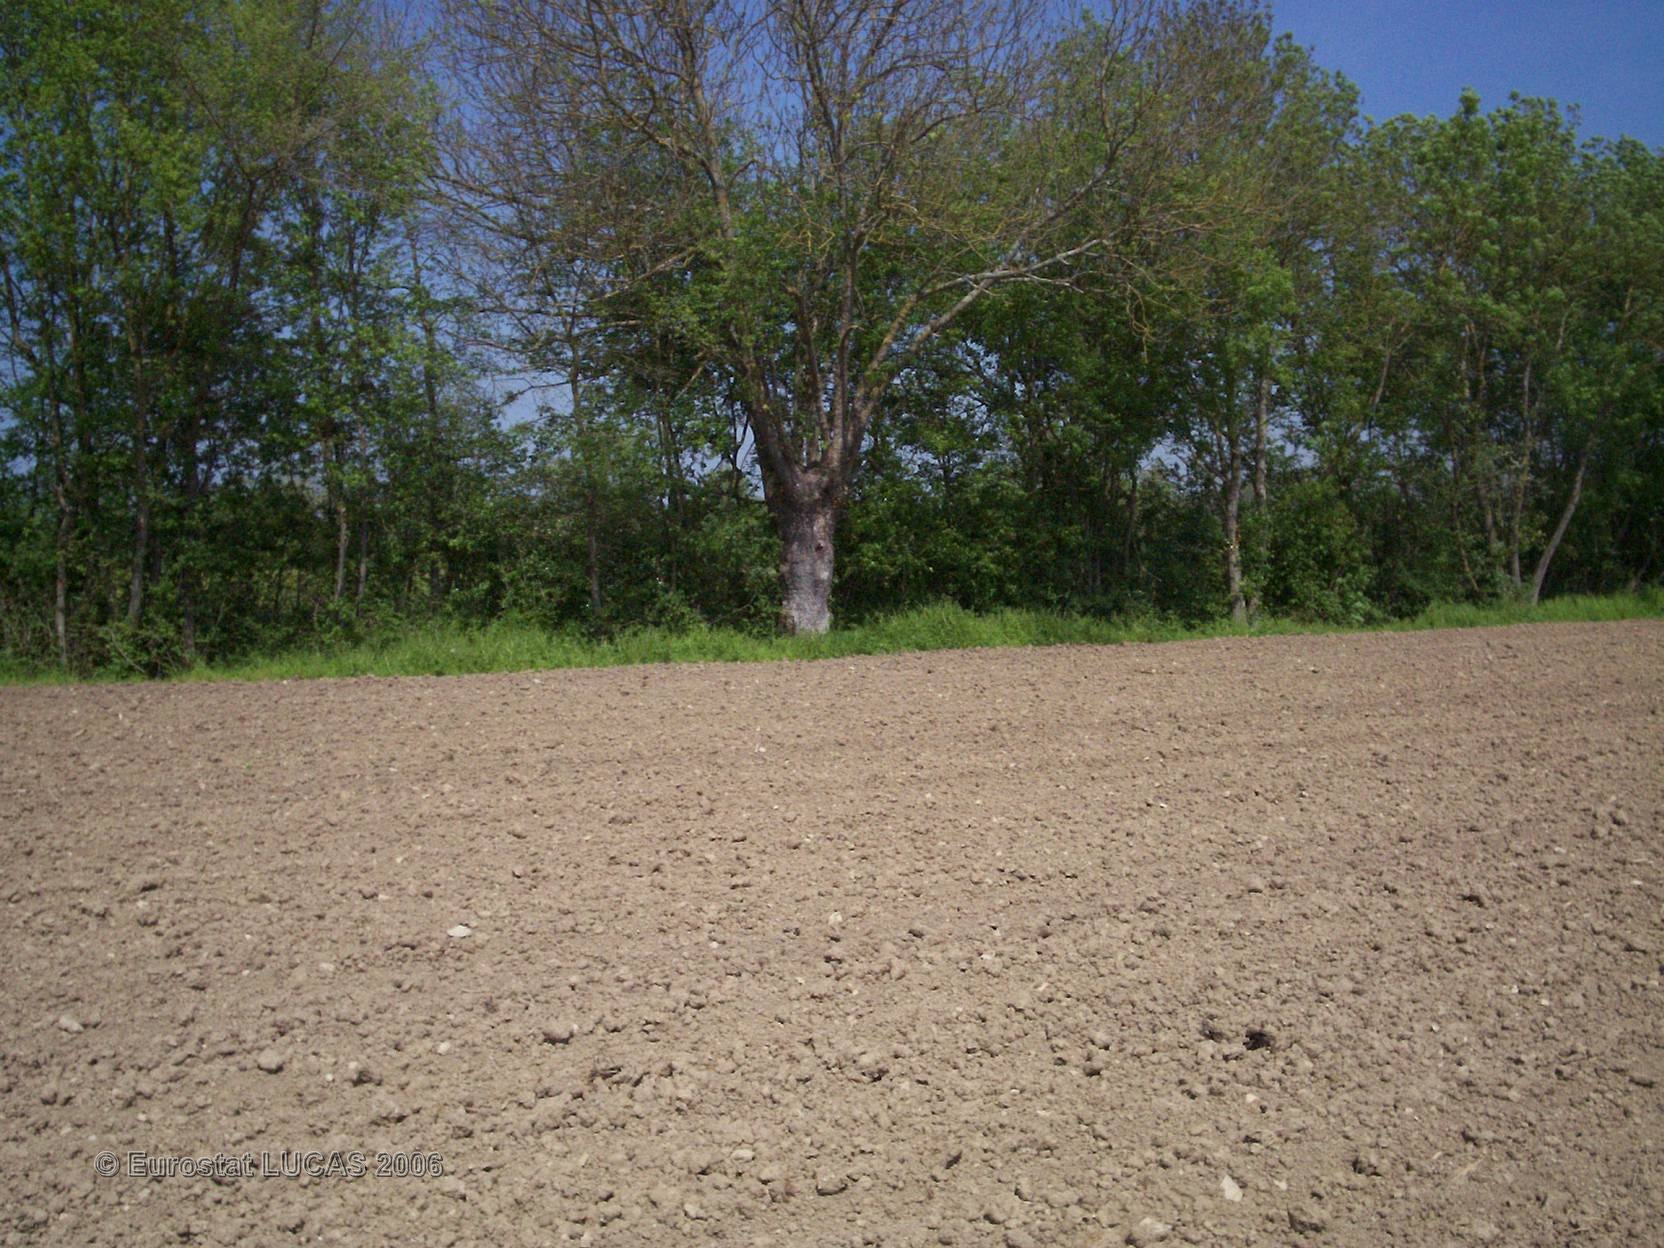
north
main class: Cropland
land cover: Maize
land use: Agriculture (excluding fallow land and kitchen gardens)
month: May
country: FR
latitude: 46.1491
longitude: -0.2377
